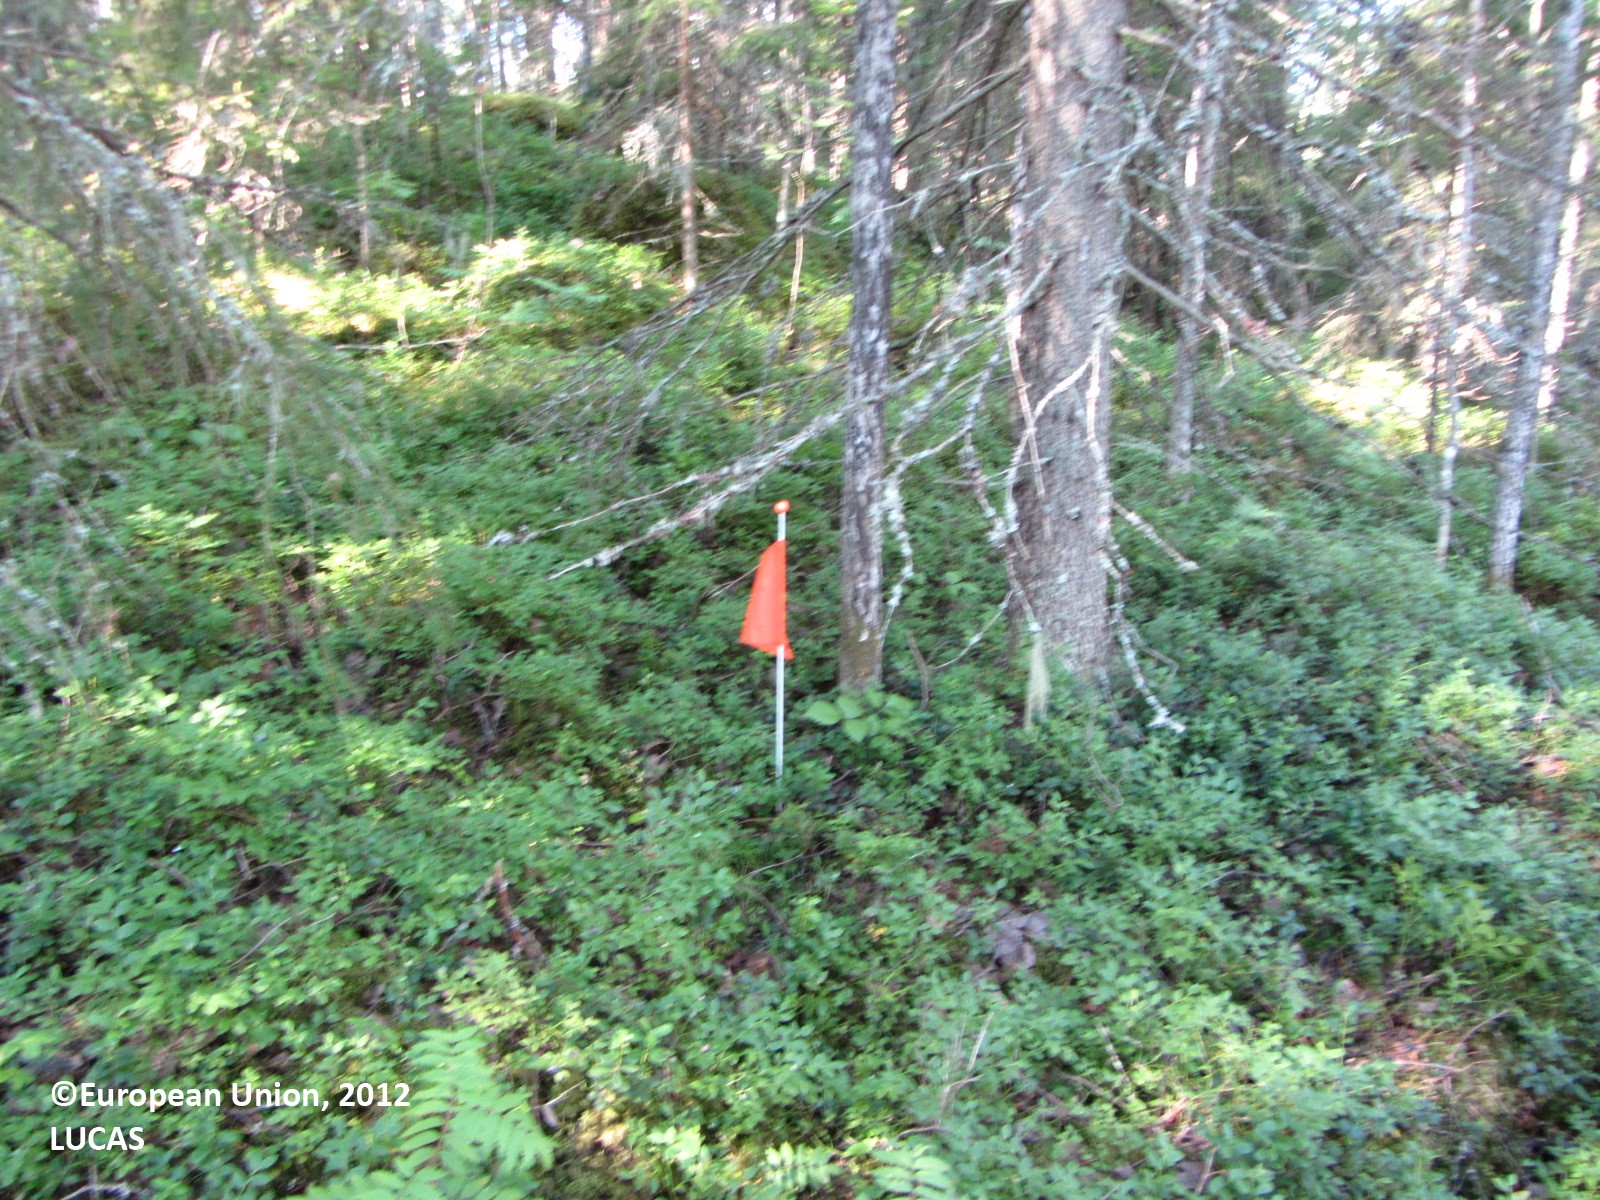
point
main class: Woodland
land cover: Other coniferous woodland
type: boreal forest
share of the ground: > 75 %
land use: Forestry
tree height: > 5 m
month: July
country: FI
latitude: 63.6722
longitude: 24.6935
